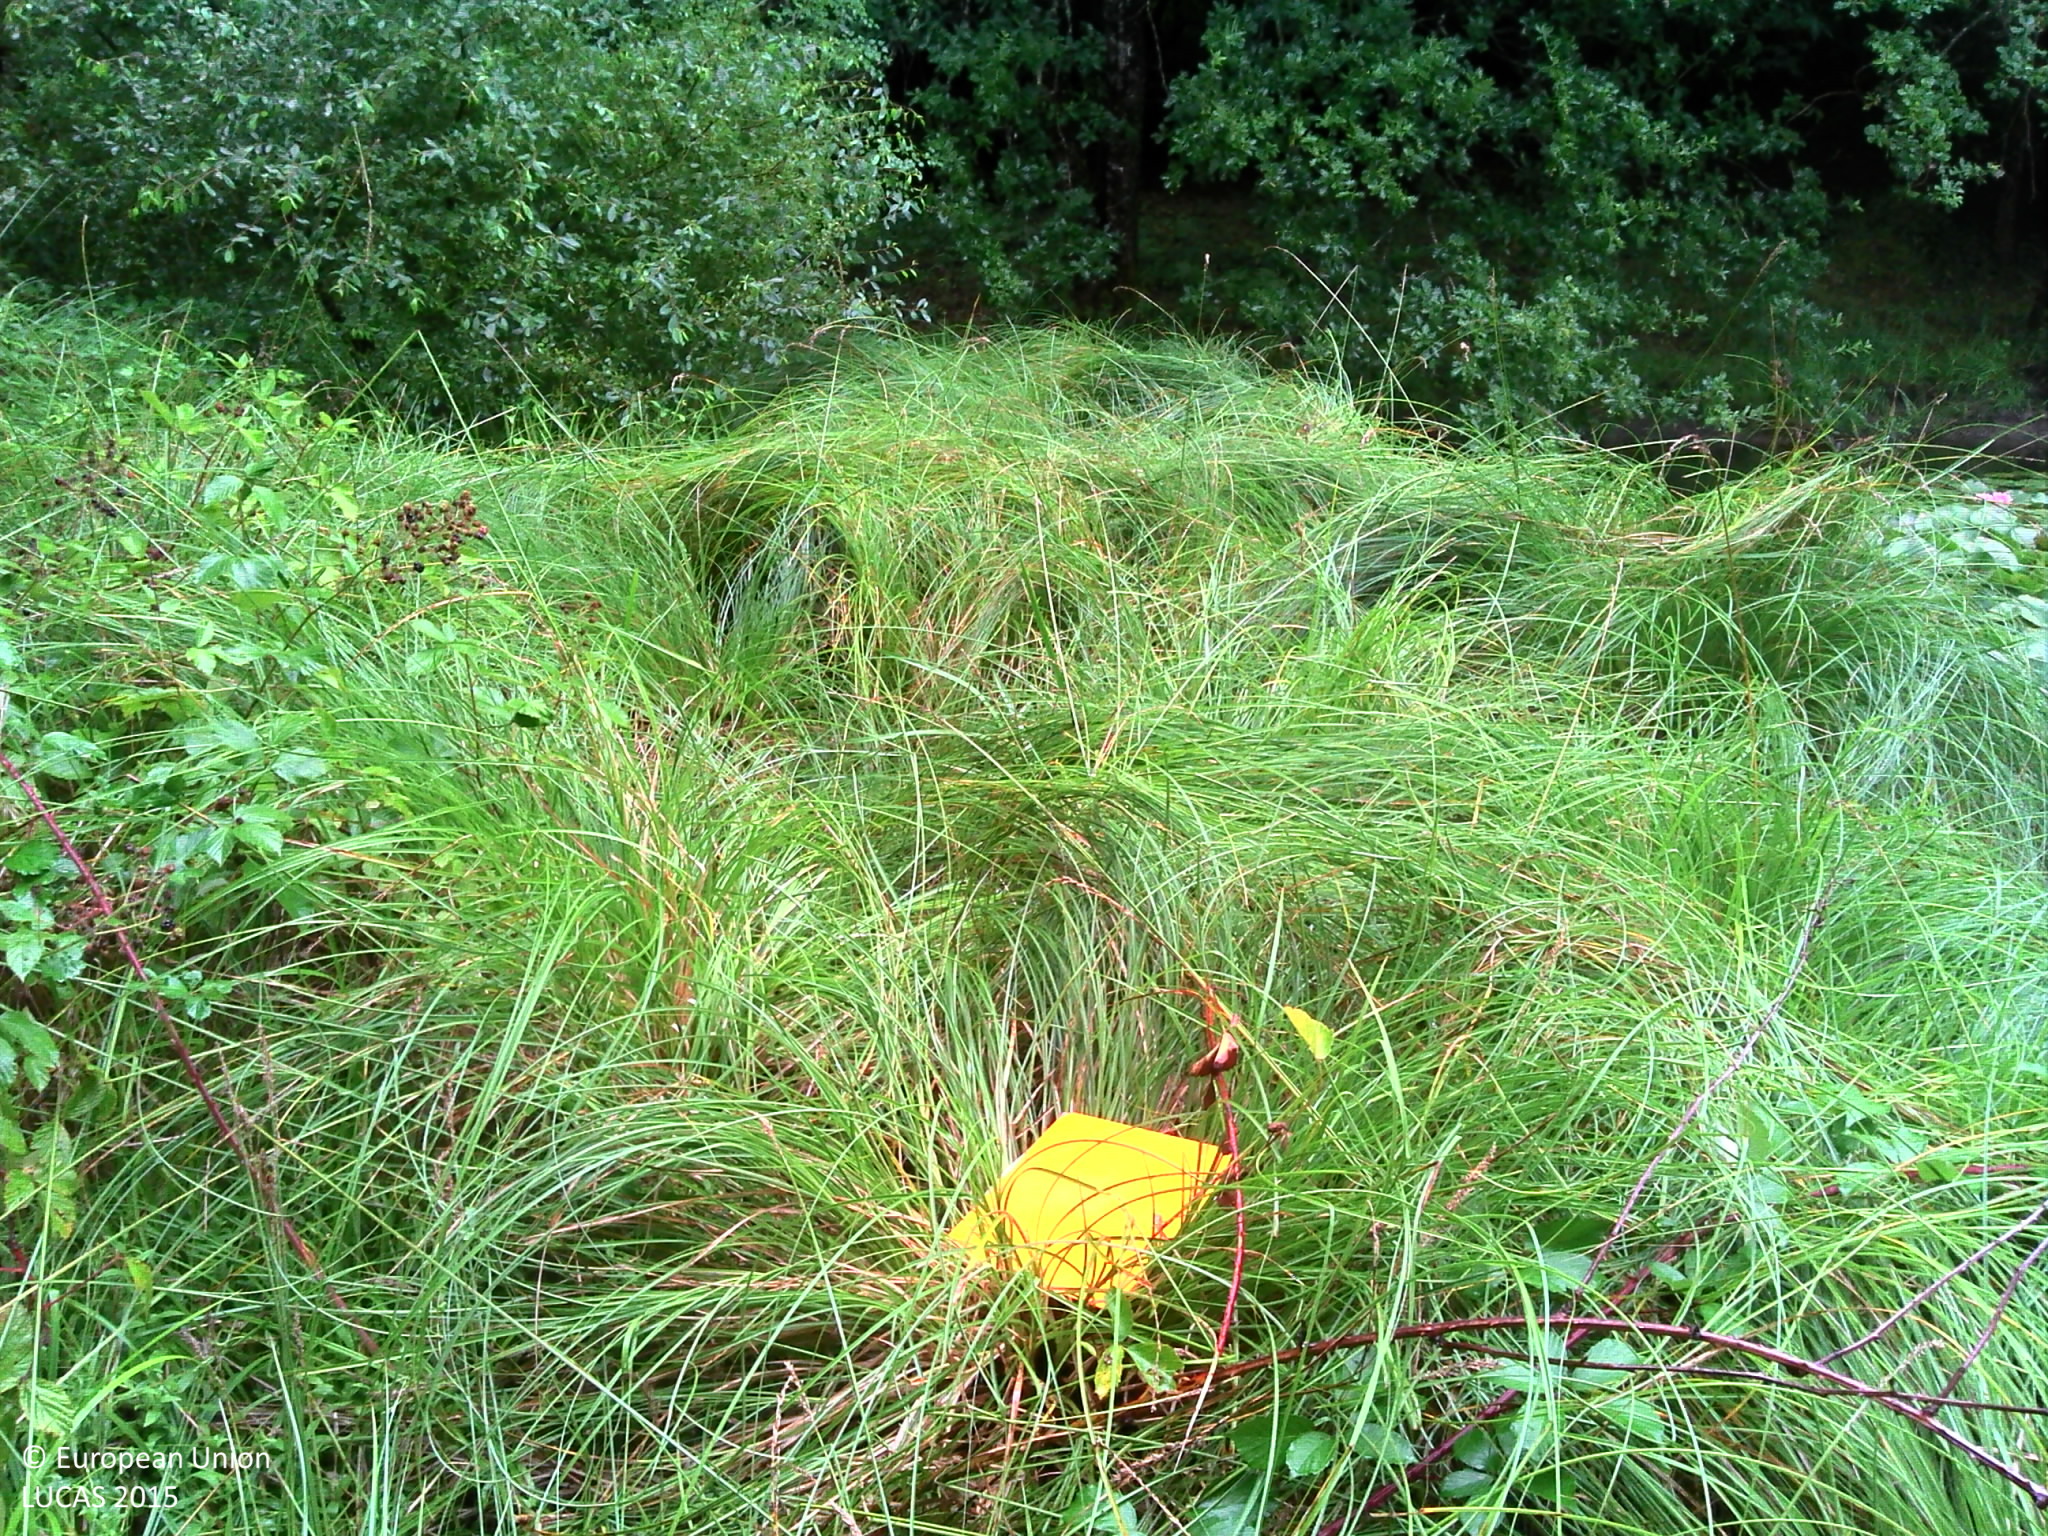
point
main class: Grassland
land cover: Grassland without tree/shrub cover
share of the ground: > 75 %
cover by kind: herbaceous plants 95 %, shrubs 5 %
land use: Forestry
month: August
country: FR
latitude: 45.5489
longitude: 0.7277
